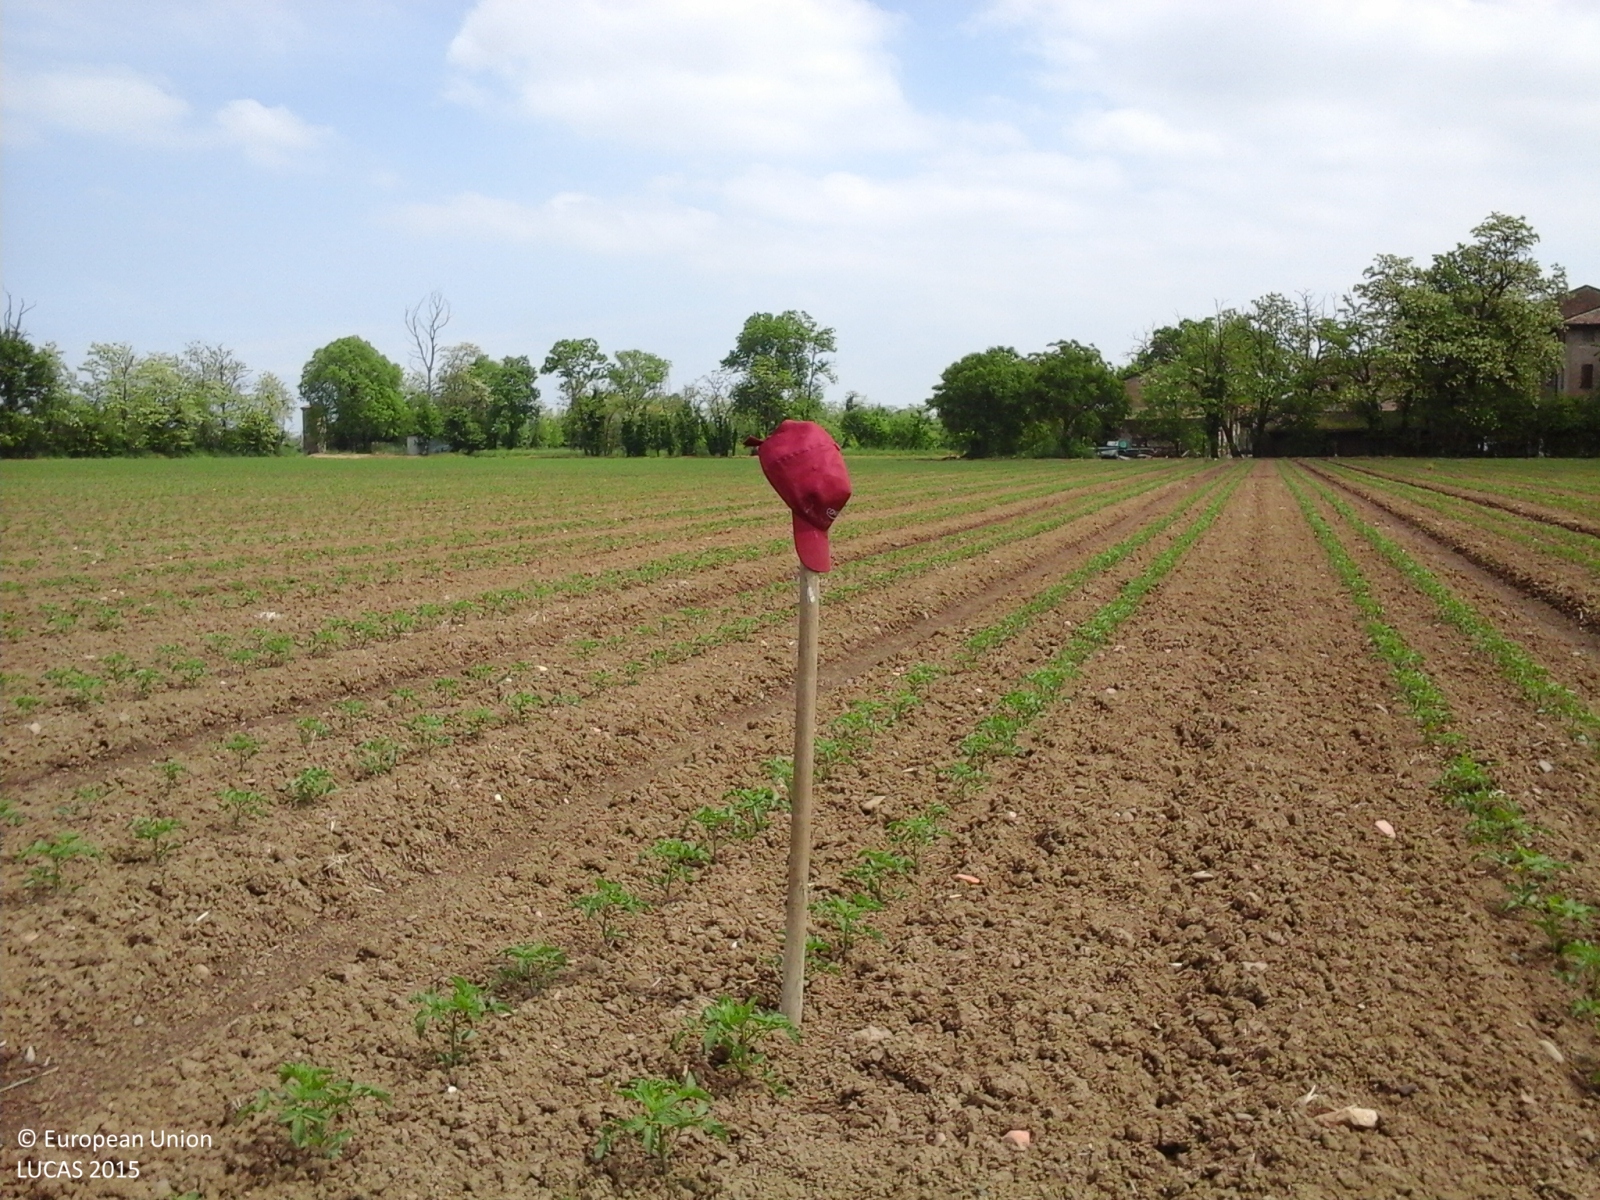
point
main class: Cropland
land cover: Tomatoes
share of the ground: < 10 %
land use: Agriculture (excluding fallow land and kitchen gardens)
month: May
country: IT
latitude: 45.0172
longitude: 9.6834
